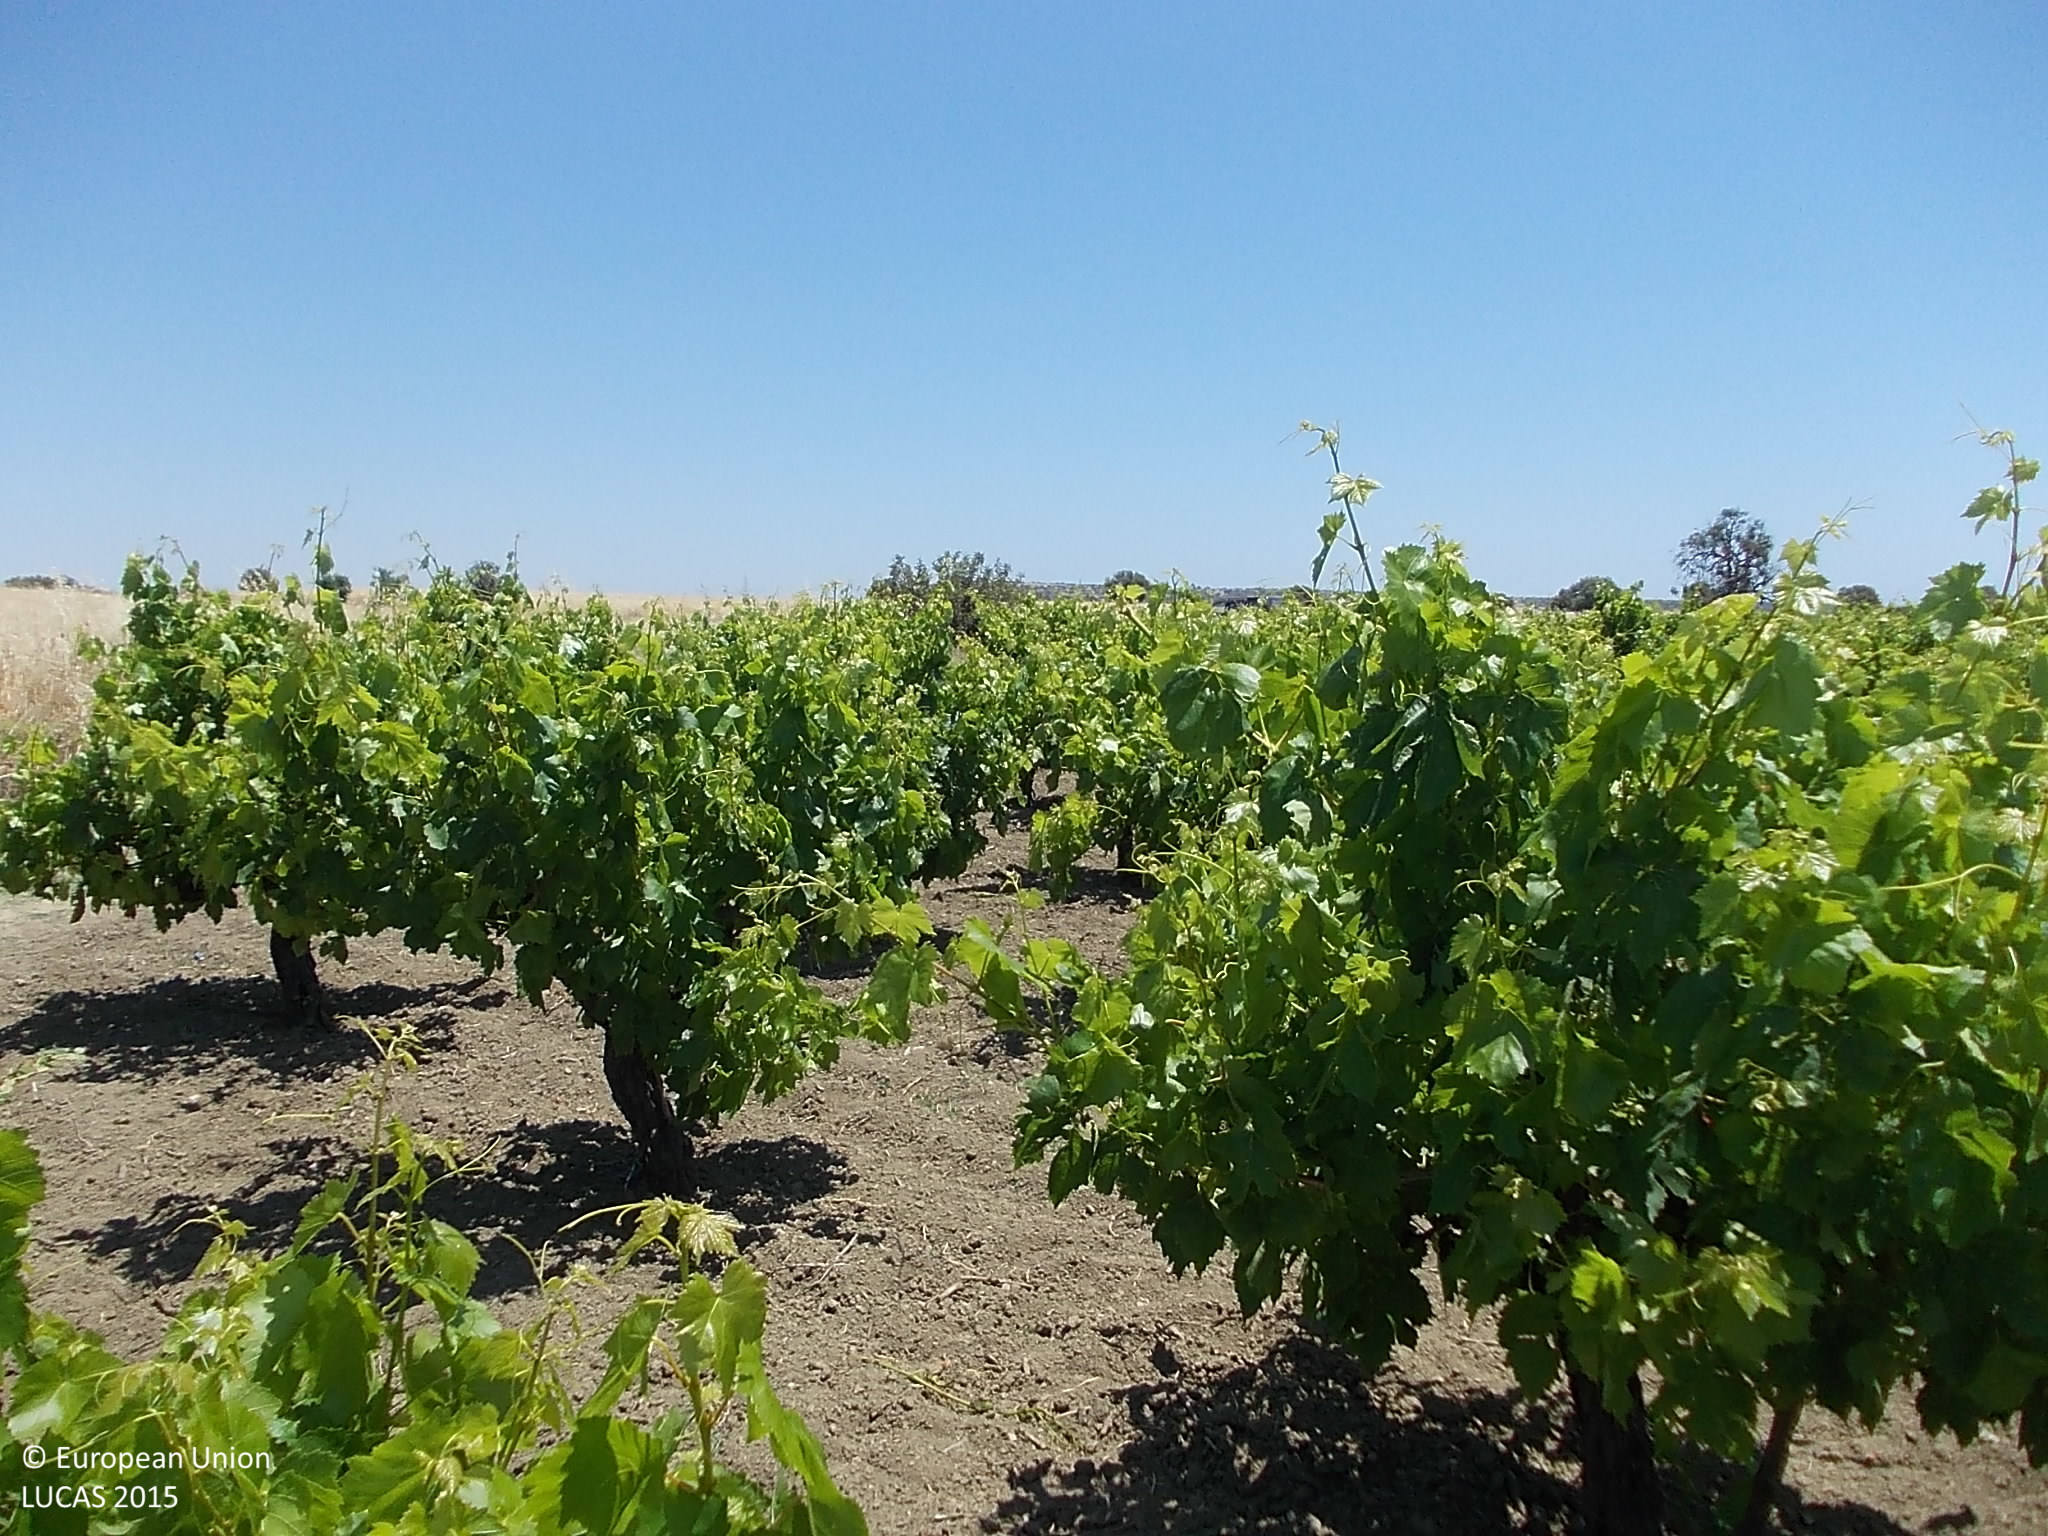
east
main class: Cropland
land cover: Vineyards
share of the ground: 50 - 75 %
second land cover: Other bare soil
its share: > 75 %
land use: Agriculture (excluding fallow land and kitchen gardens)
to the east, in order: Vineyards; Other bare soil; Tracks; Lines of trees; Durum wheat; Grass margins; Tracks; Durum wheat
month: May
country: CY
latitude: 34.6690
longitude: 32.7542
